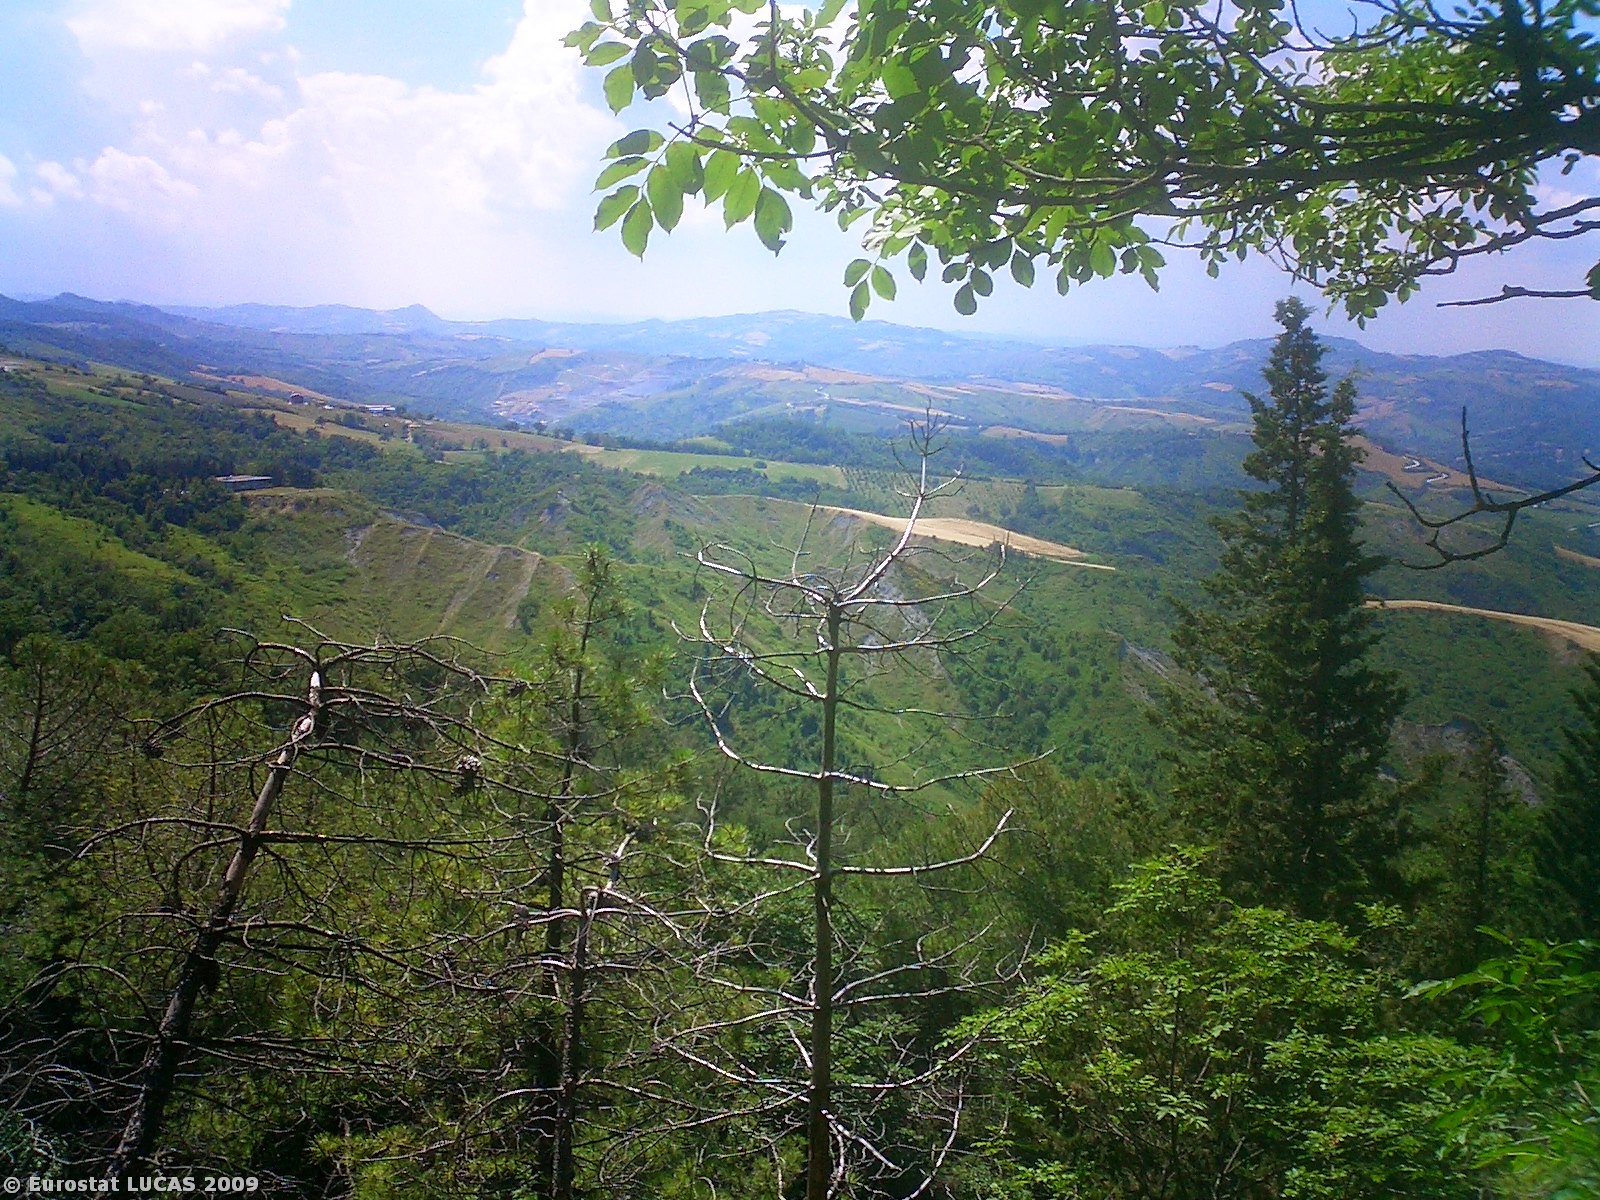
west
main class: Woodland
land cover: Mixed woodland
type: mesophytic deciduous forest
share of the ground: > 75 %
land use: Nature reserves
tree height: > 5 m
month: June
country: IT
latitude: 43.9805
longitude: 12.3756
